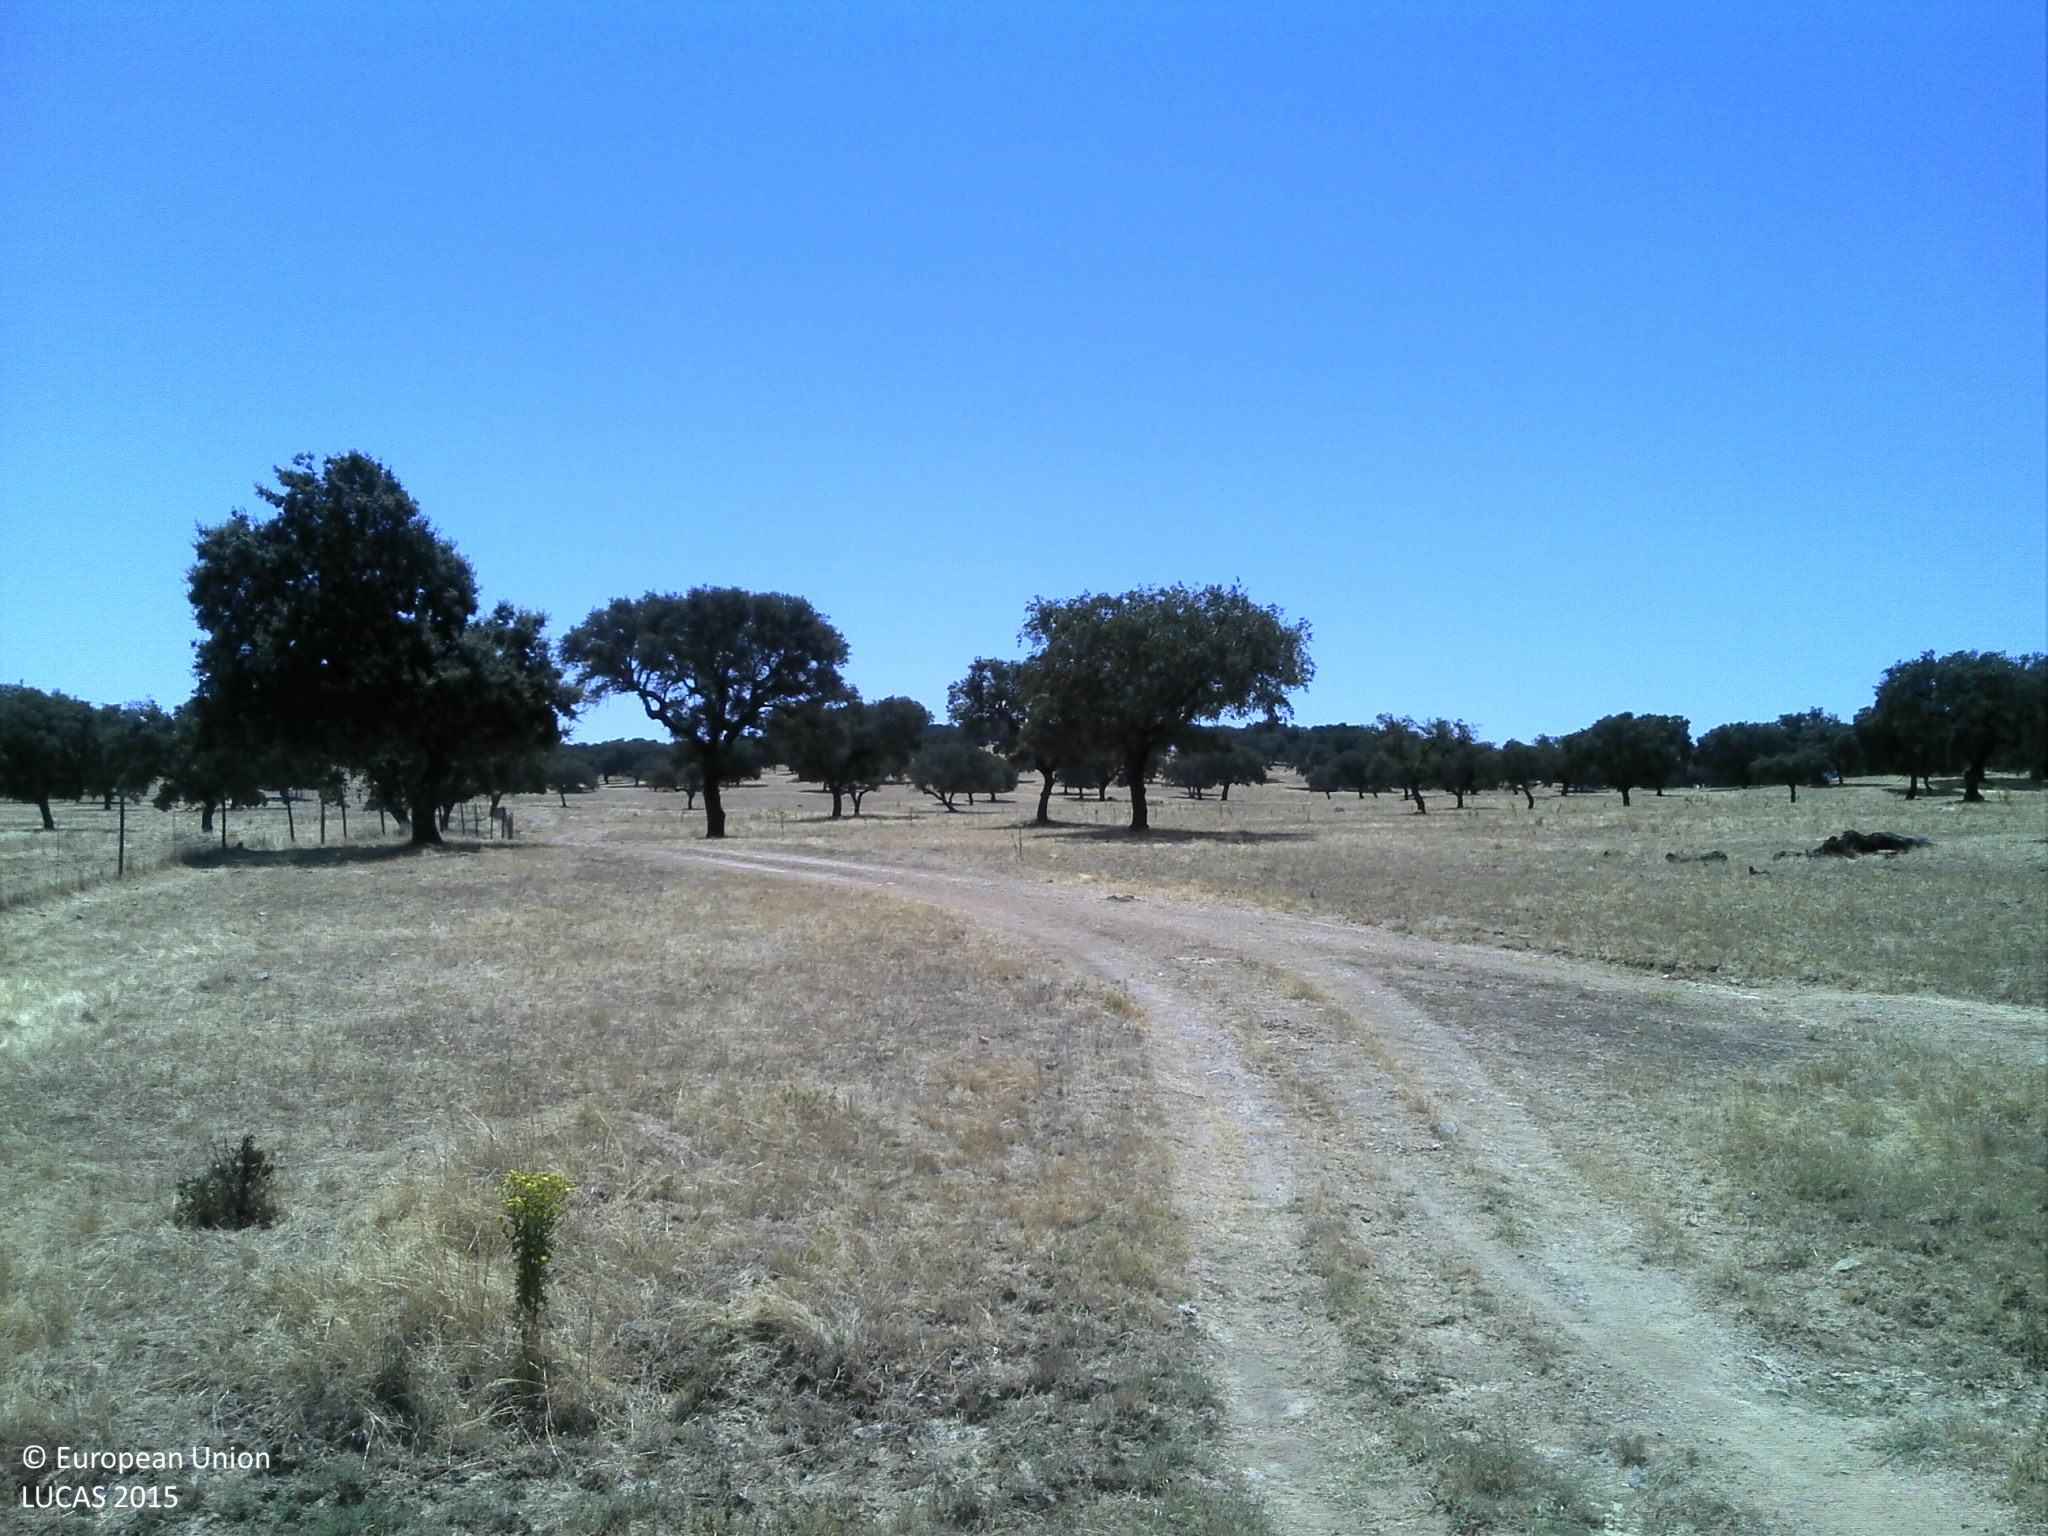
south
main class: Grassland
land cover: Grassland without tree/shrub cover
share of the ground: 25 - 50 %
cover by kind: unconsolidated bare surface 70 %, herbaceous plants 30 %
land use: Agriculture (excluding fallow land and kitchen gardens)
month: July
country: PT
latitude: 39.1382
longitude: -7.5219
